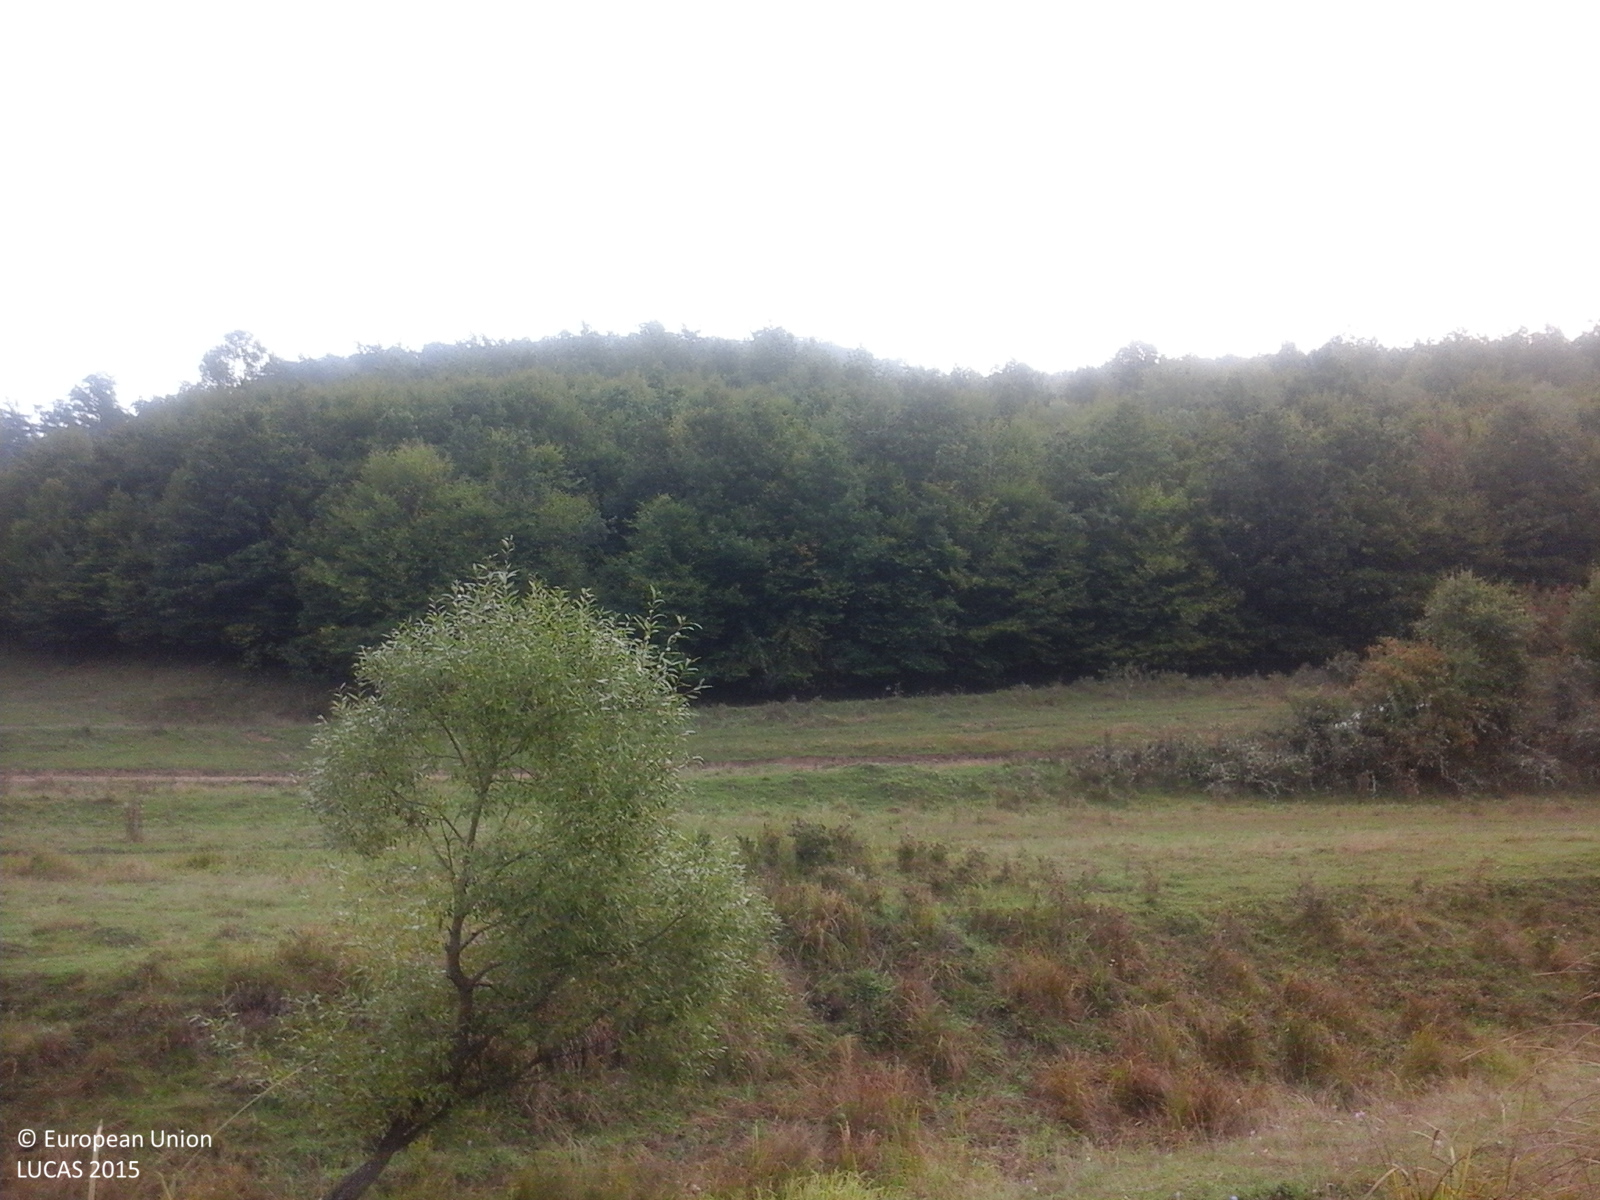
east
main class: Grassland
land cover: Spontaneously vegetated surfaces
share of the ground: > 75 %
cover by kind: herbaceous plants 100 %
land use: Agriculture (excluding fallow land and kitchen gardens)
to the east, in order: Spontaneously vegetated surfaces; Ditches and canals; Grassland without tree/shrub cover; Tracks; Spontaneously vegetated surfaces; Tracks; Spontaneously vegetated surfaces; Broadleaved woodland
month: September
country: RO
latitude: 46.9798
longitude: 23.1182
